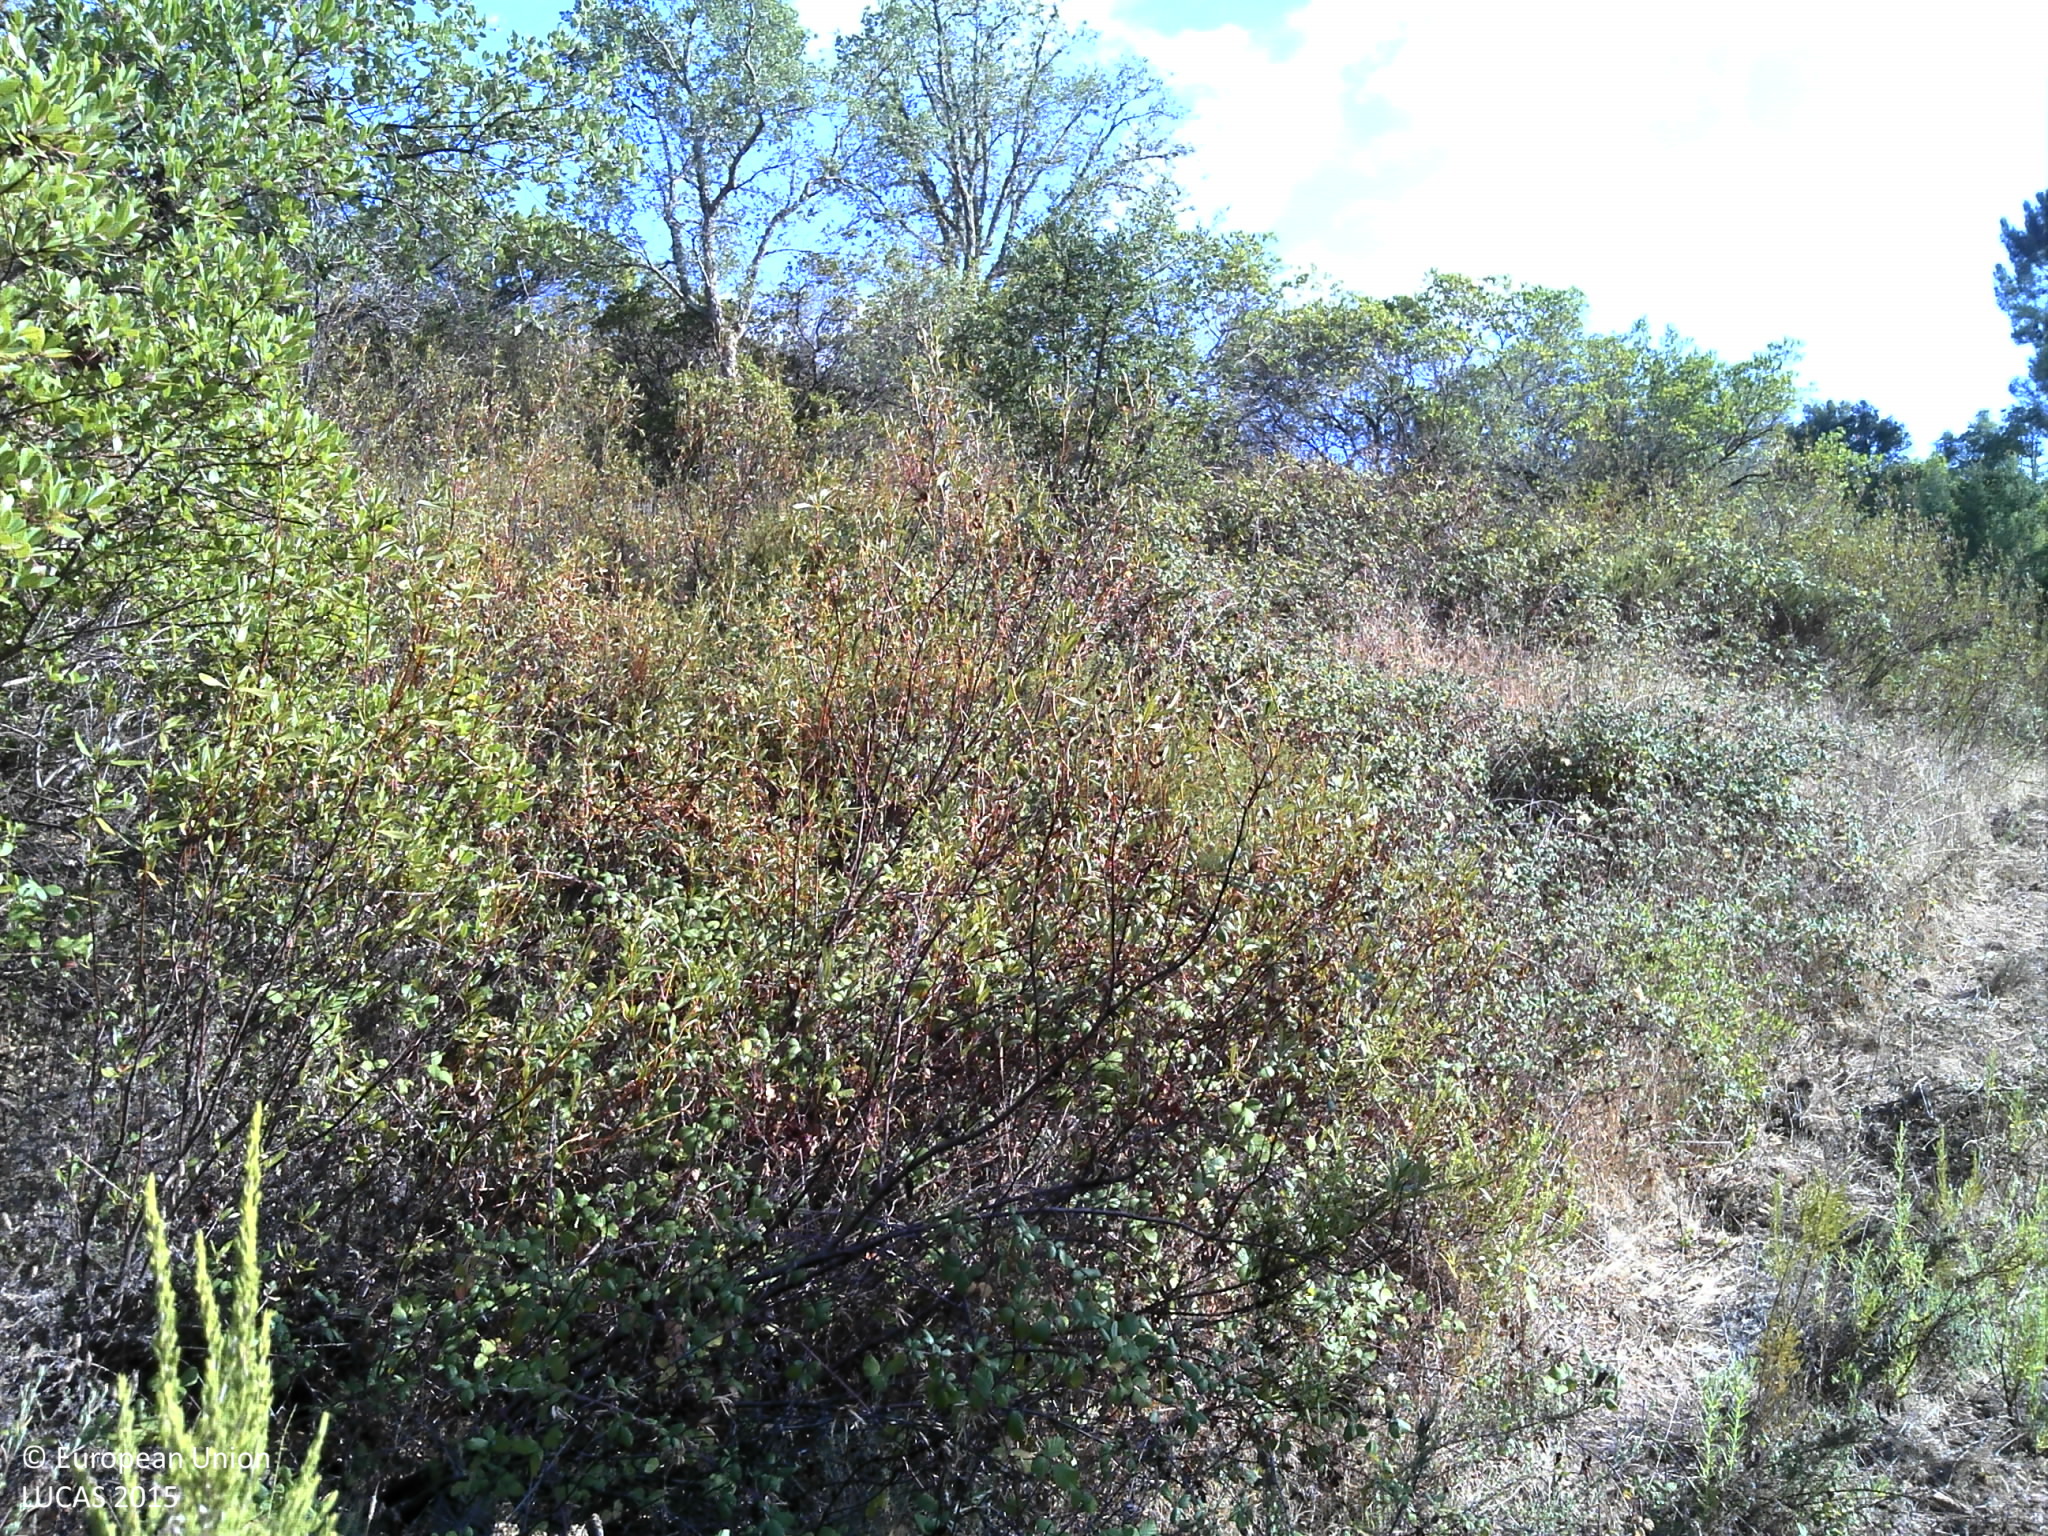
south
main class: Shrubland
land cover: Shrubland with sparse tree cover
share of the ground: 50 - 75 %
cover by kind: shrubs 70 %, unconsolidated bare surface 25 %, broadleaved forest trees 5 %
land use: Forestry
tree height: < 5 m
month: September
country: PT
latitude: 37.3892
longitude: -8.4507
